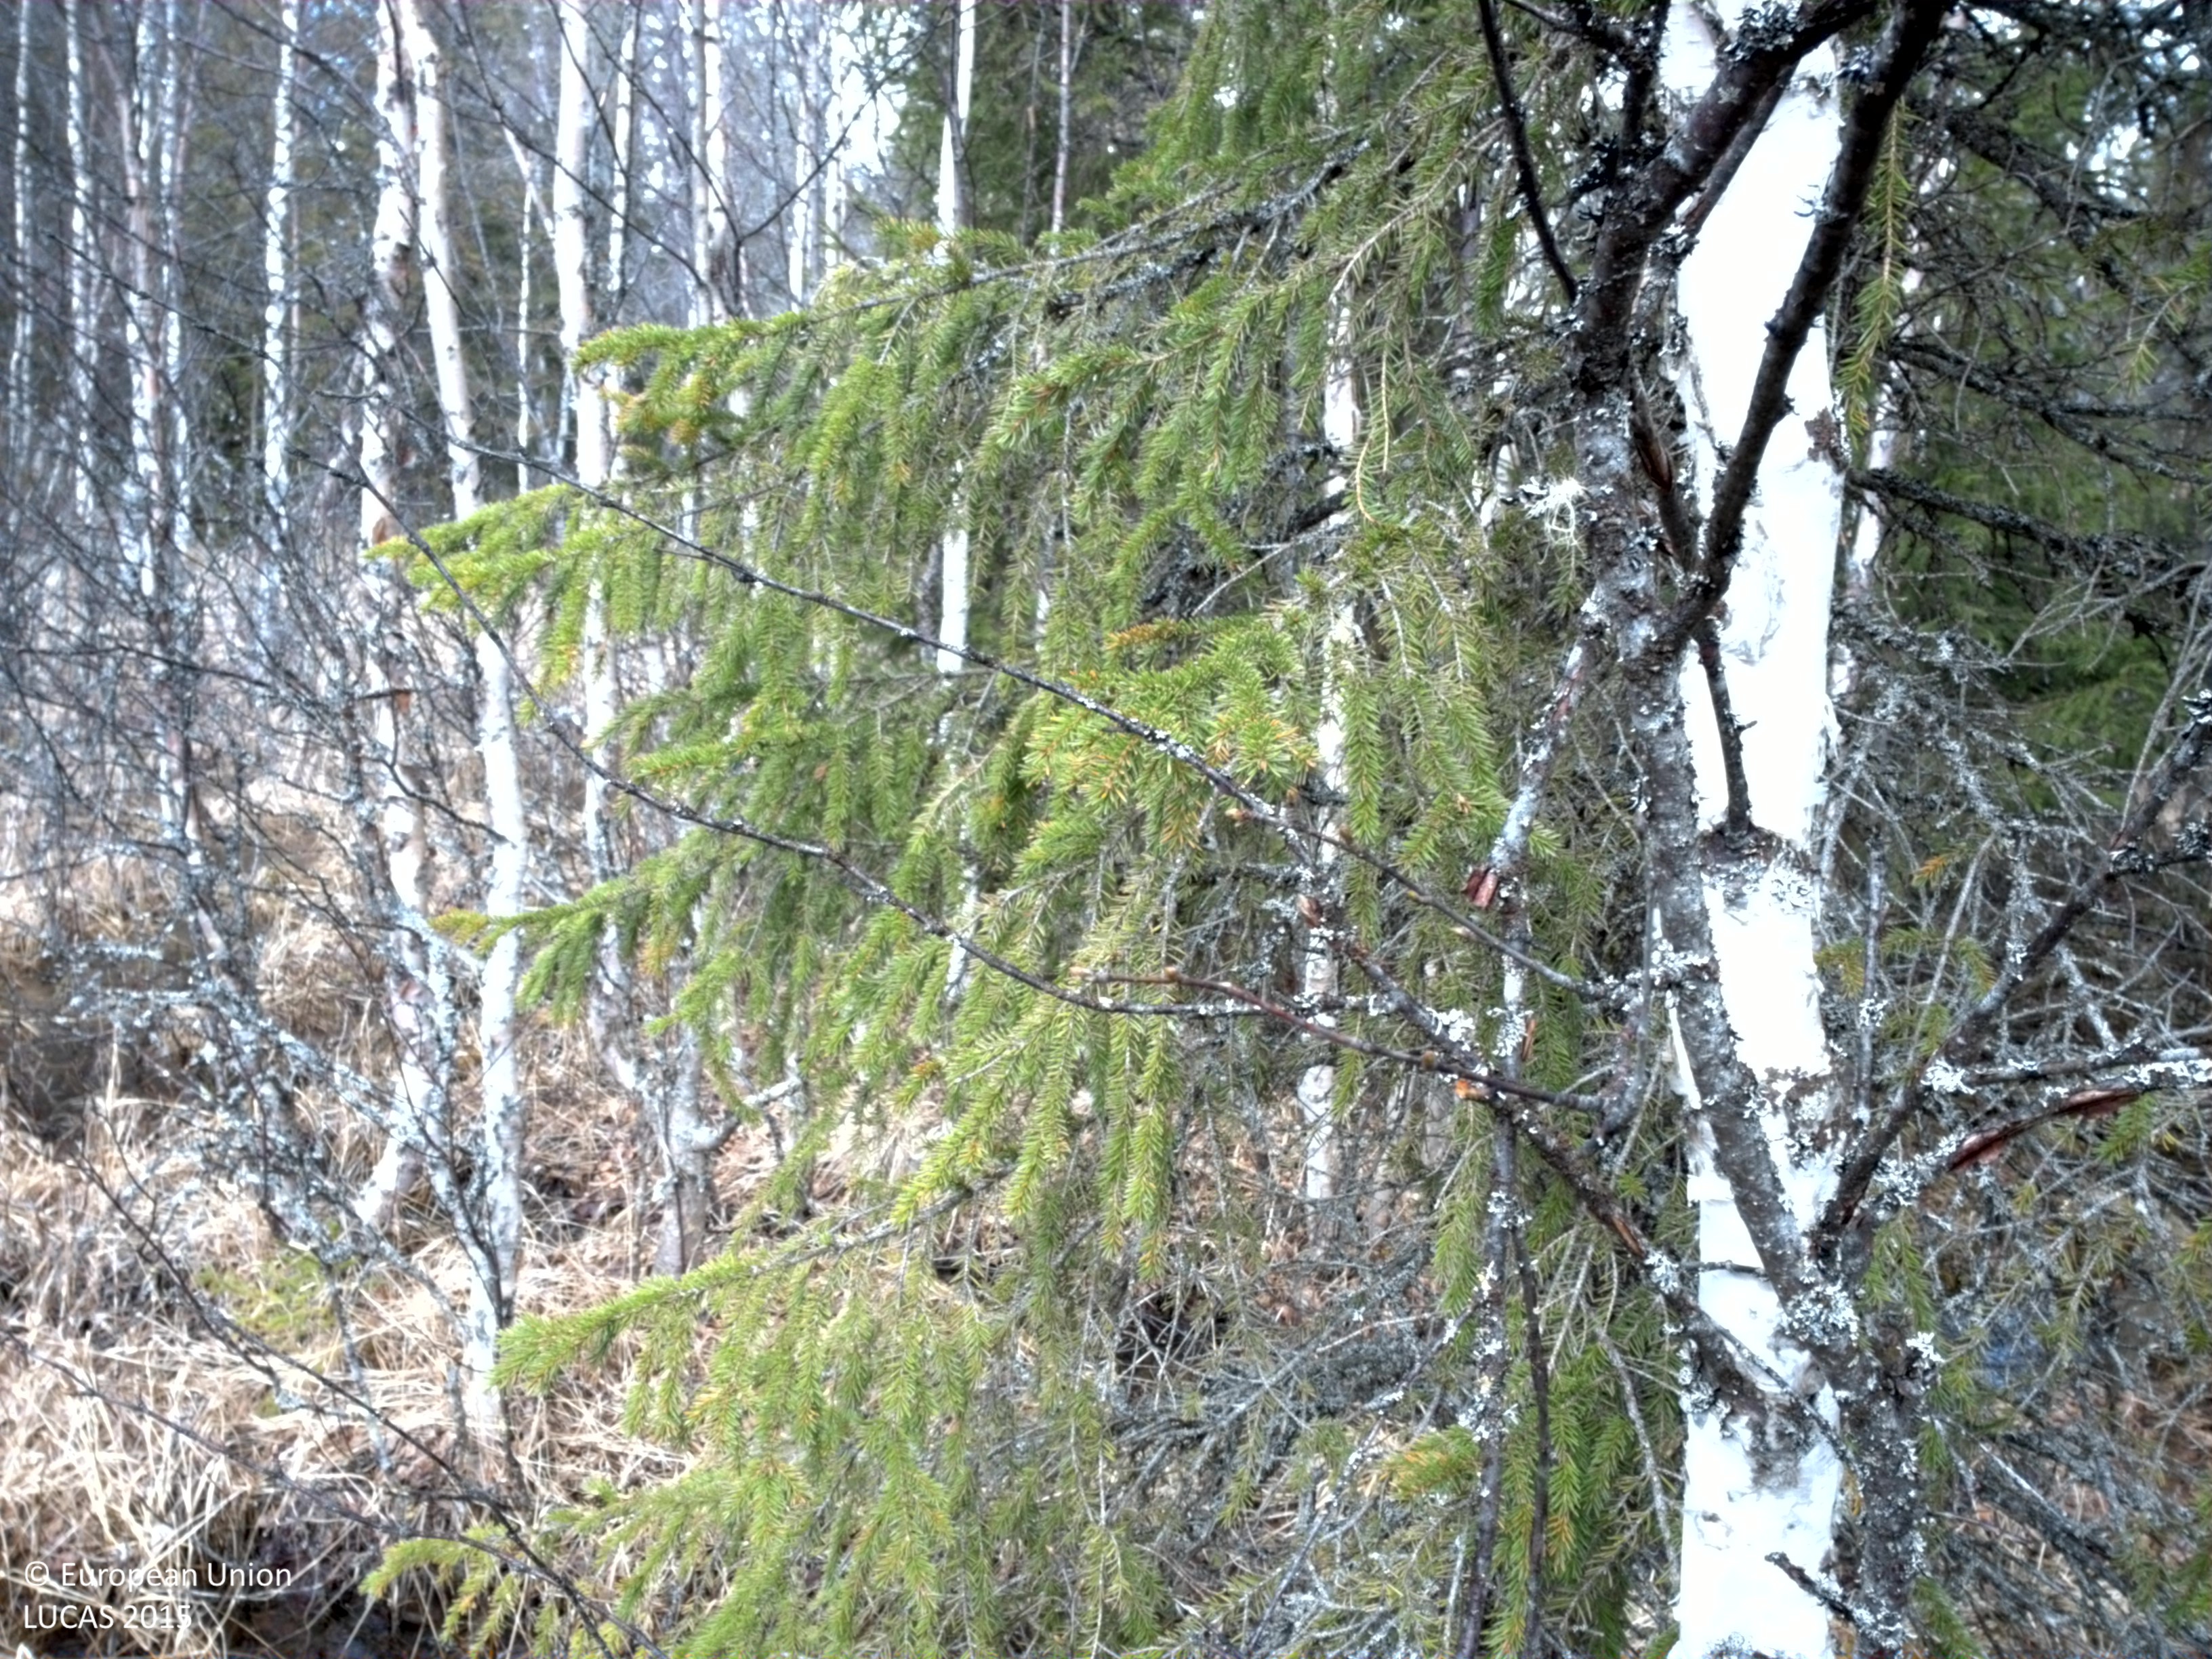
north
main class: Woodland
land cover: Spruce dominated mixed woodland
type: boreal forest
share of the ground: > 75 %
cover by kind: coniferous forest trees 75 %, broadleaved forest trees 25 %
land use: Forestry
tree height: > 5 m
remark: Temporary flooded
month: May
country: SE
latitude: 63.3558
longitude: 13.9179
